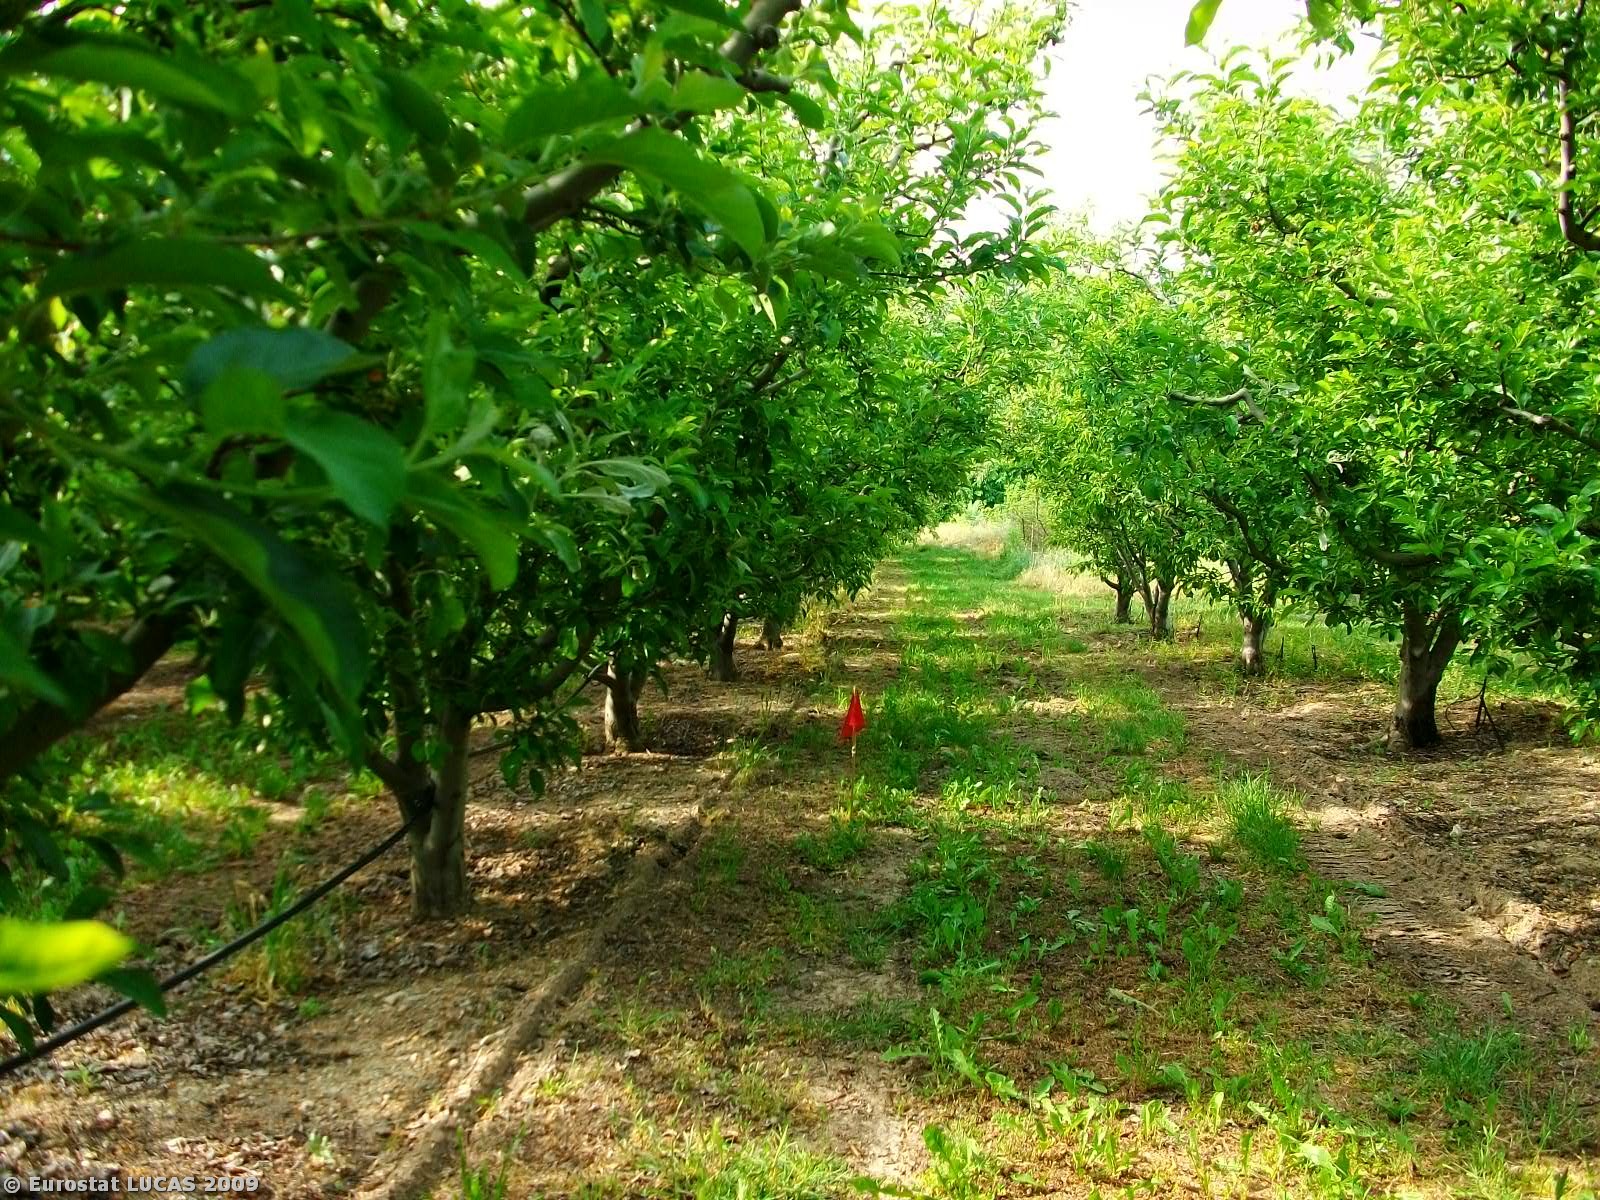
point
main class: Cropland
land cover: Apple fruit
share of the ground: > 75 %
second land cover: Grassland with sparse tree/shrub cover
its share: 50 - 75 %
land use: Agriculture (excluding fallow land and kitchen gardens)
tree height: > 5 m
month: May
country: GR
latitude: 40.7335
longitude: 21.8498
